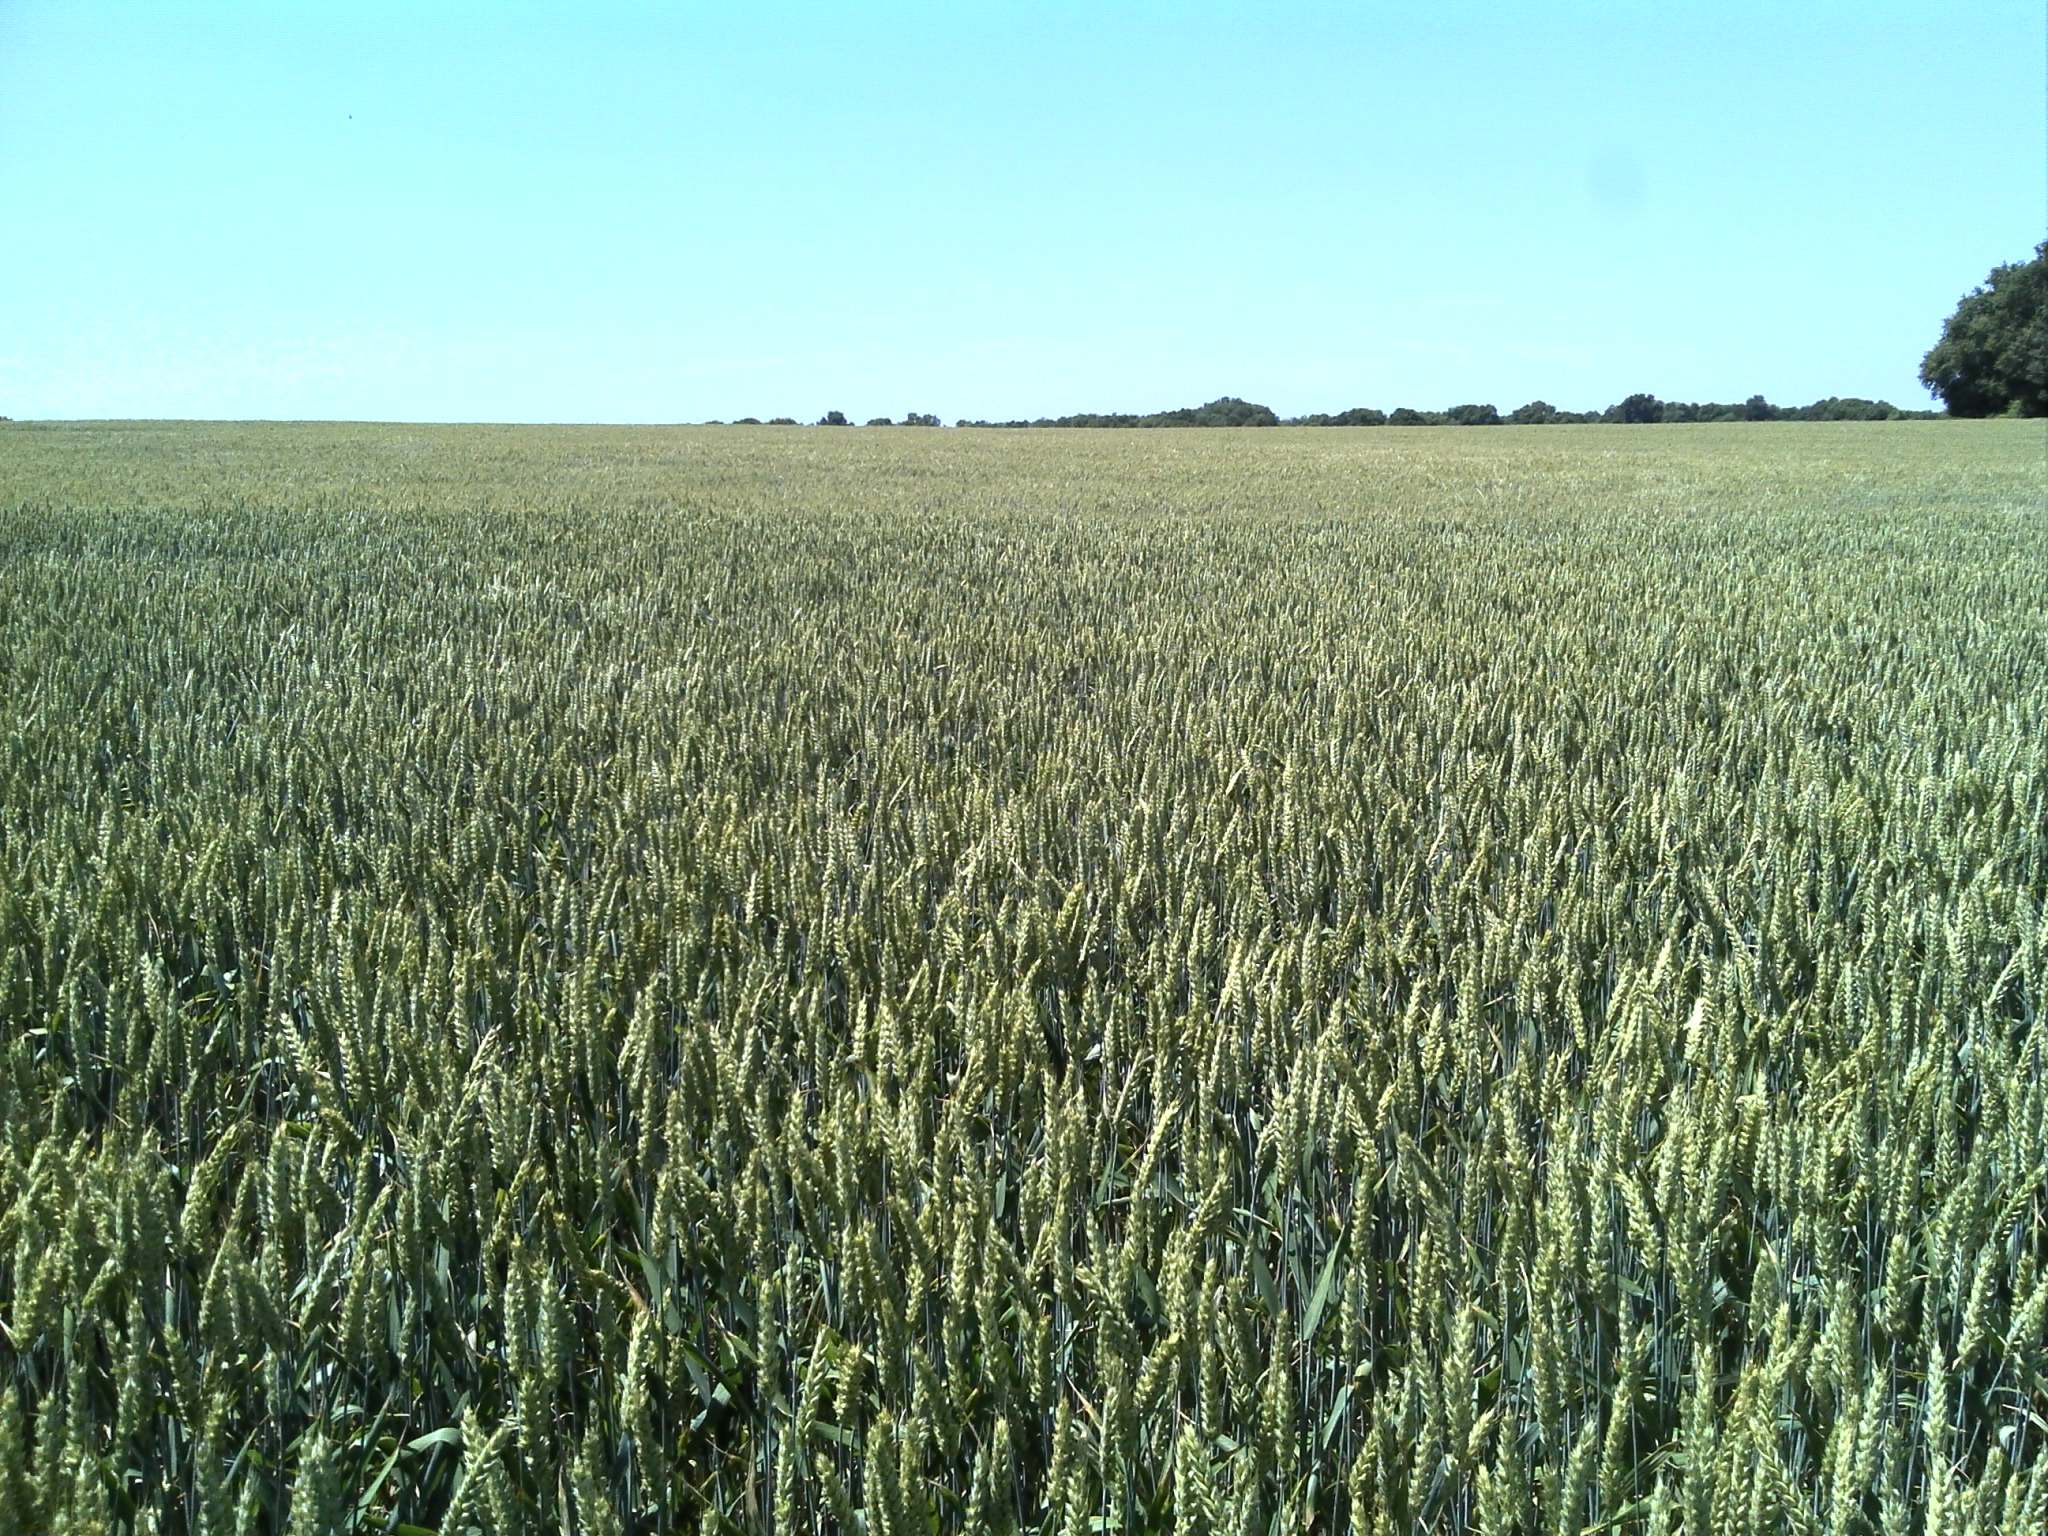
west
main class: Cropland
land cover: Common wheat
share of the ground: > 75 %
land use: Agriculture (excluding fallow land and kitchen gardens)
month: June
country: FR
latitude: 47.1651
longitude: 1.4254
